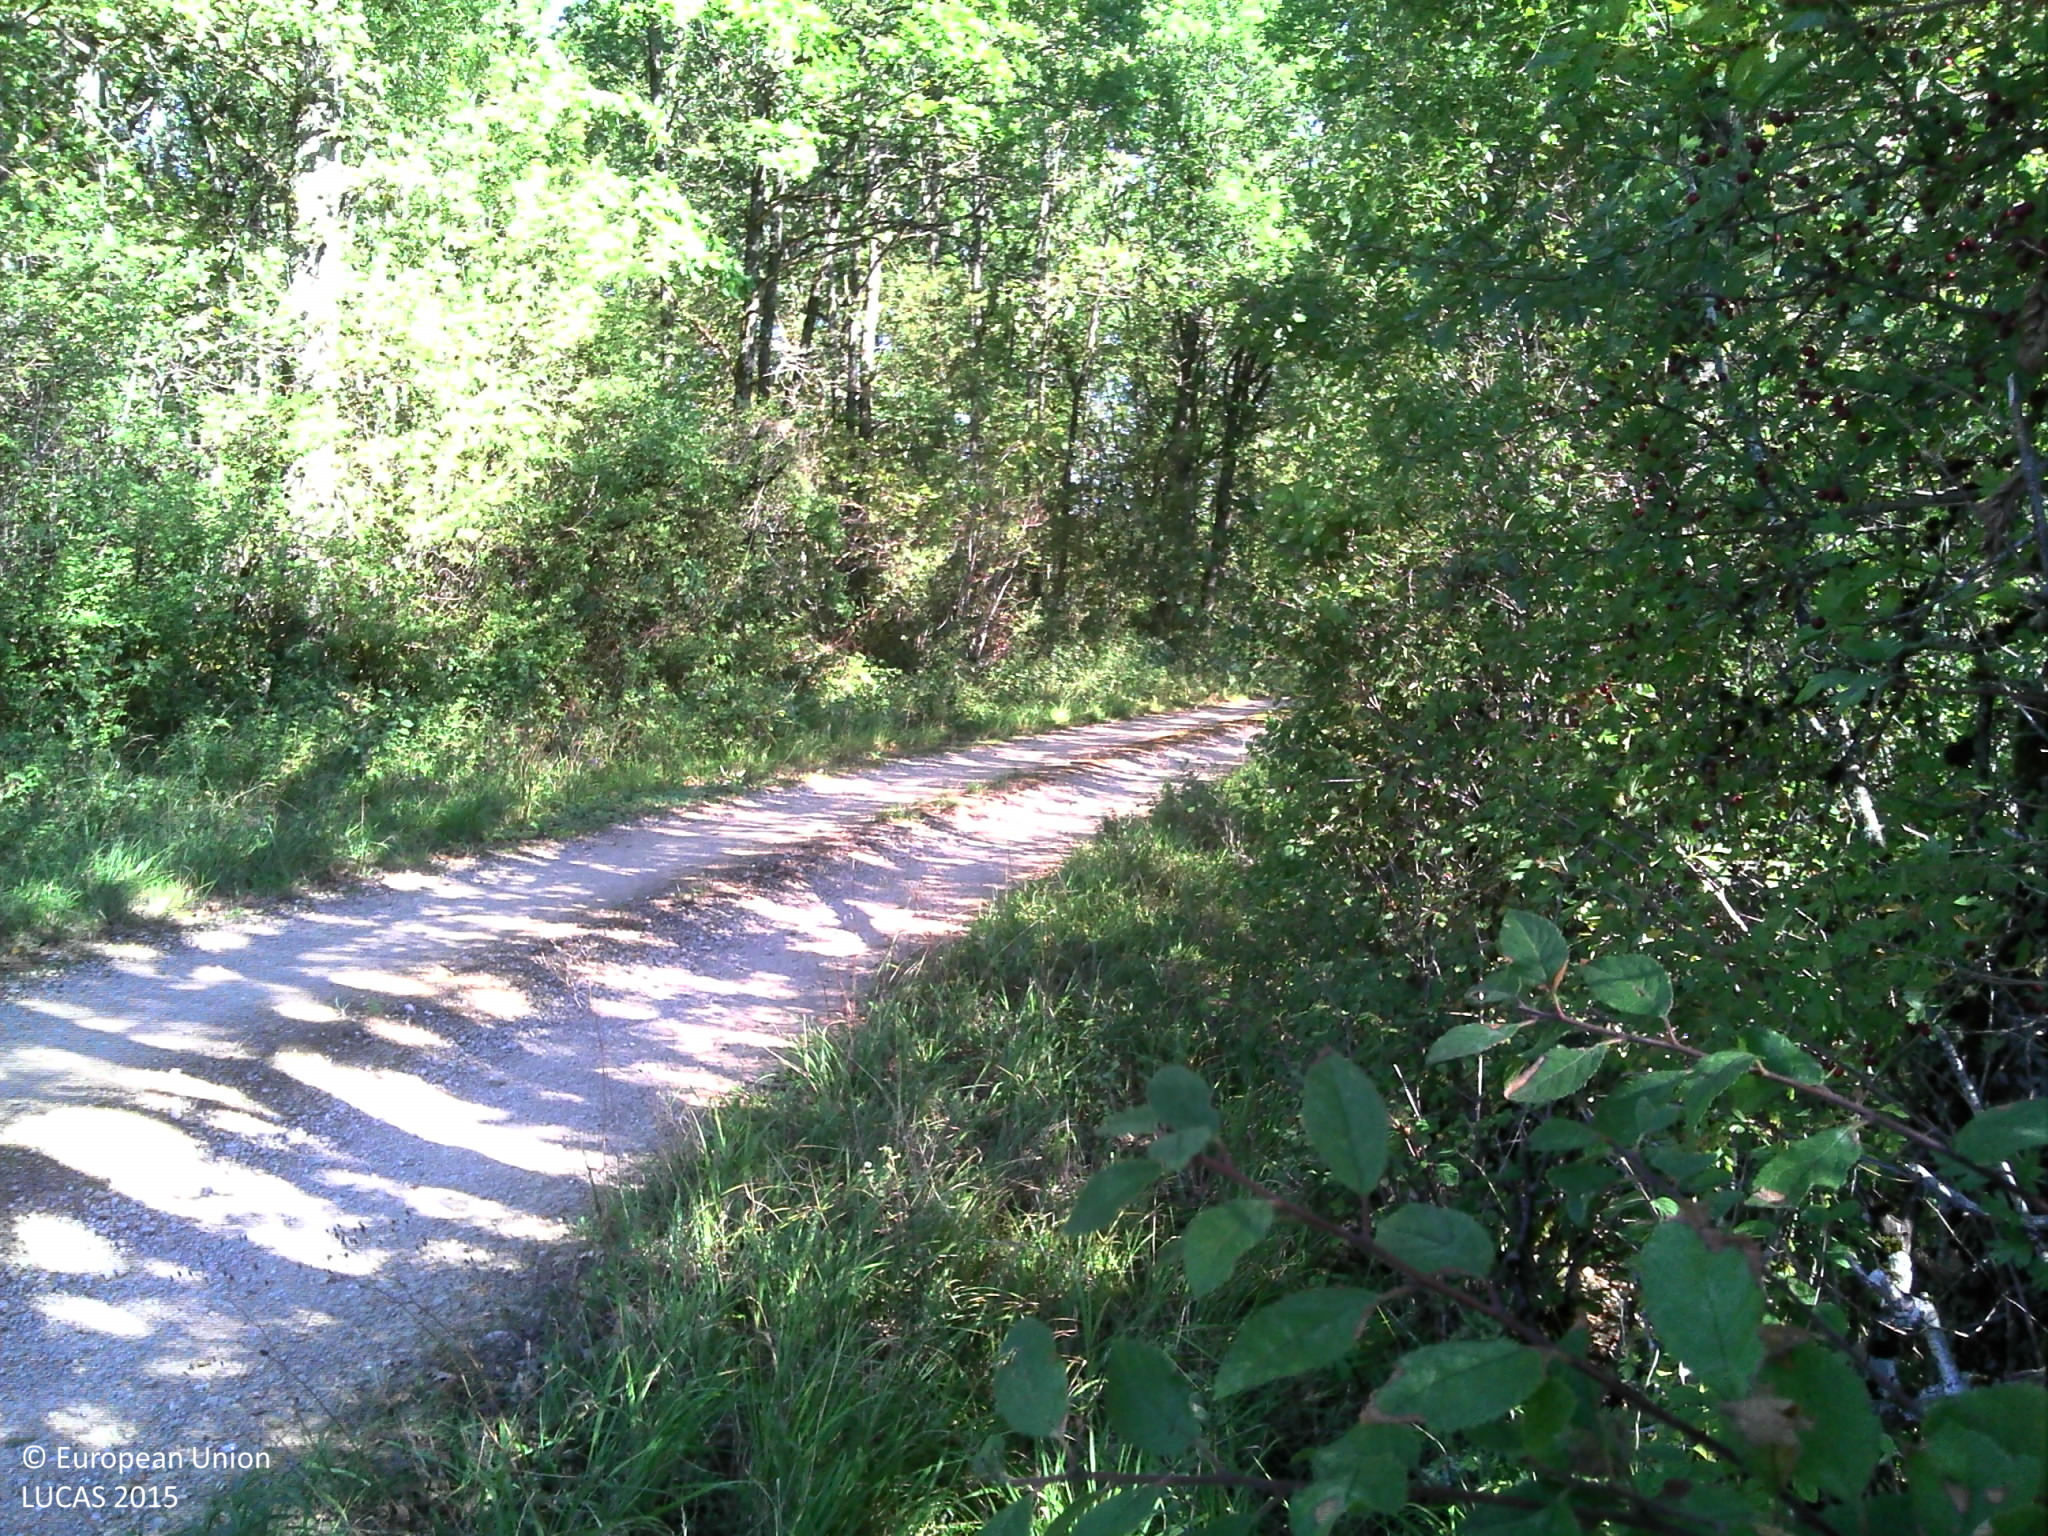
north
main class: Woodland
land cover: Broadleaved woodland
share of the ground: > 75 %
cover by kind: broadleaved forest trees 90 %, herbaceous plants 5 %, lichens and mosses 5 %
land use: Semi-natural and natural areas not in use
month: September
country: FR
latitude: 47.5721
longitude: 4.3222
